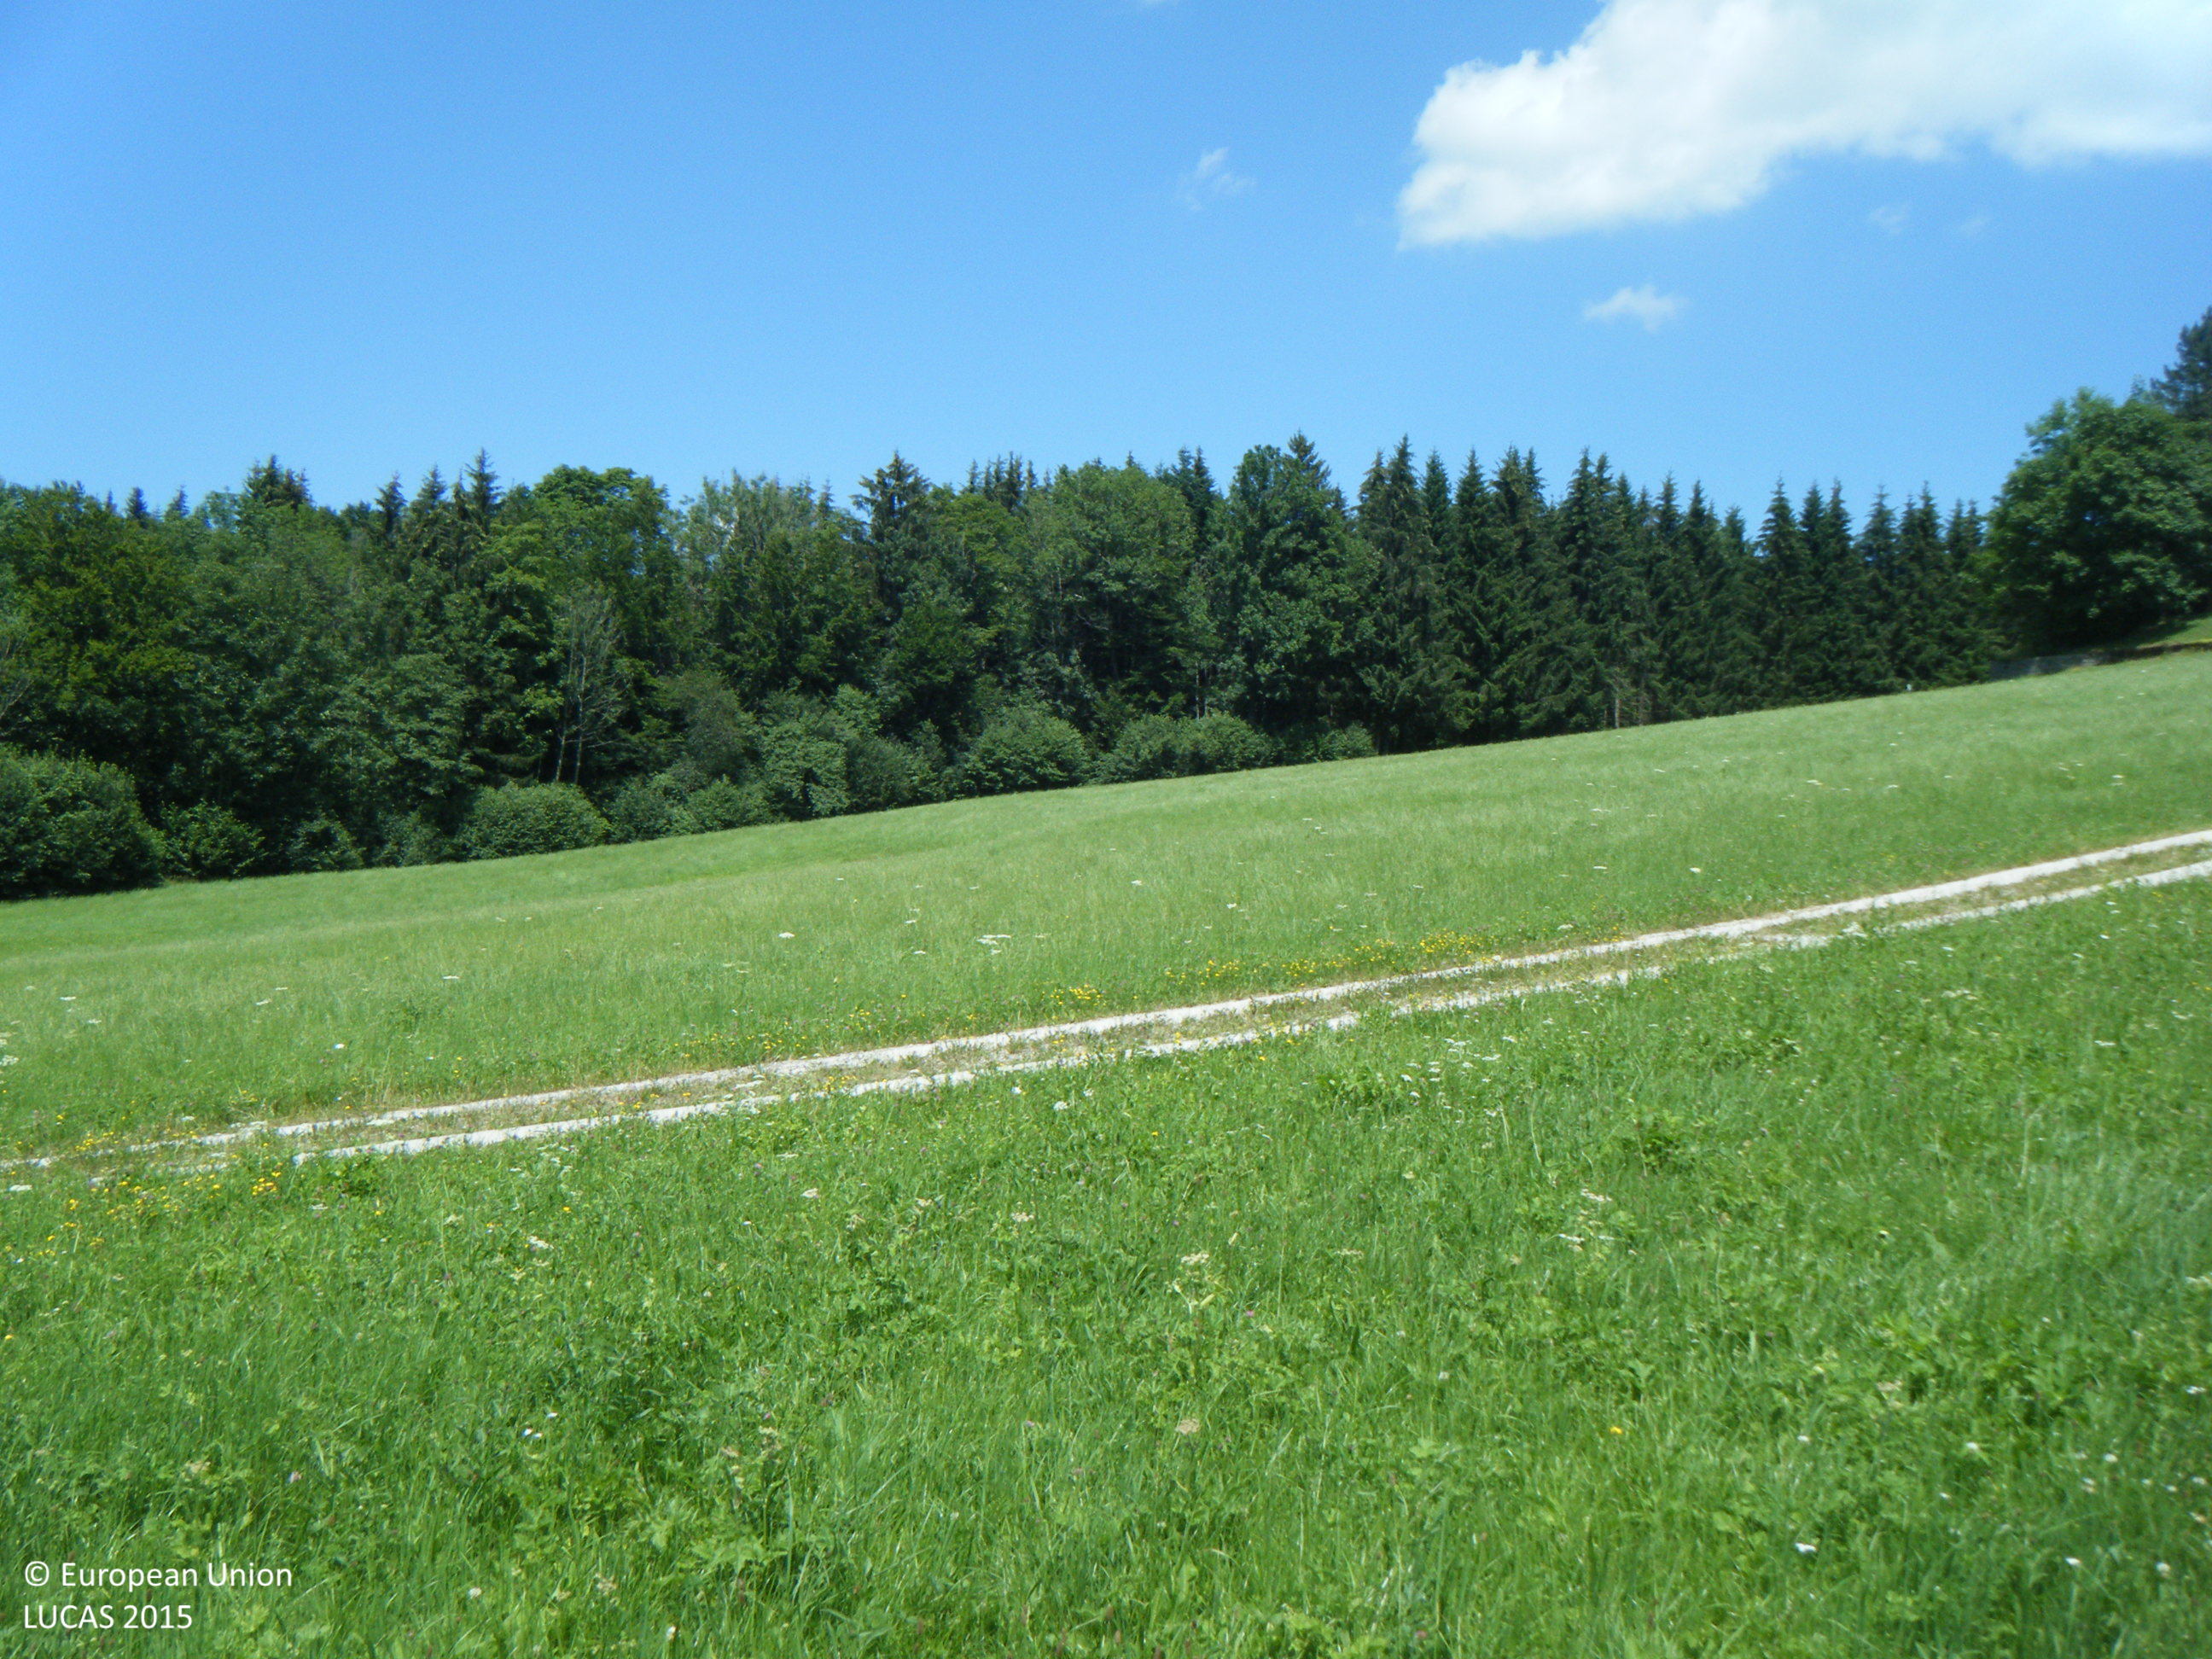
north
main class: Grassland
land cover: Grassland without tree/shrub cover
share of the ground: > 75 %
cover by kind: herbaceous plants 100 %
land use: Agriculture (excluding fallow land and kitchen gardens)
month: July
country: AT
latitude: 47.8442
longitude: 13.4864
